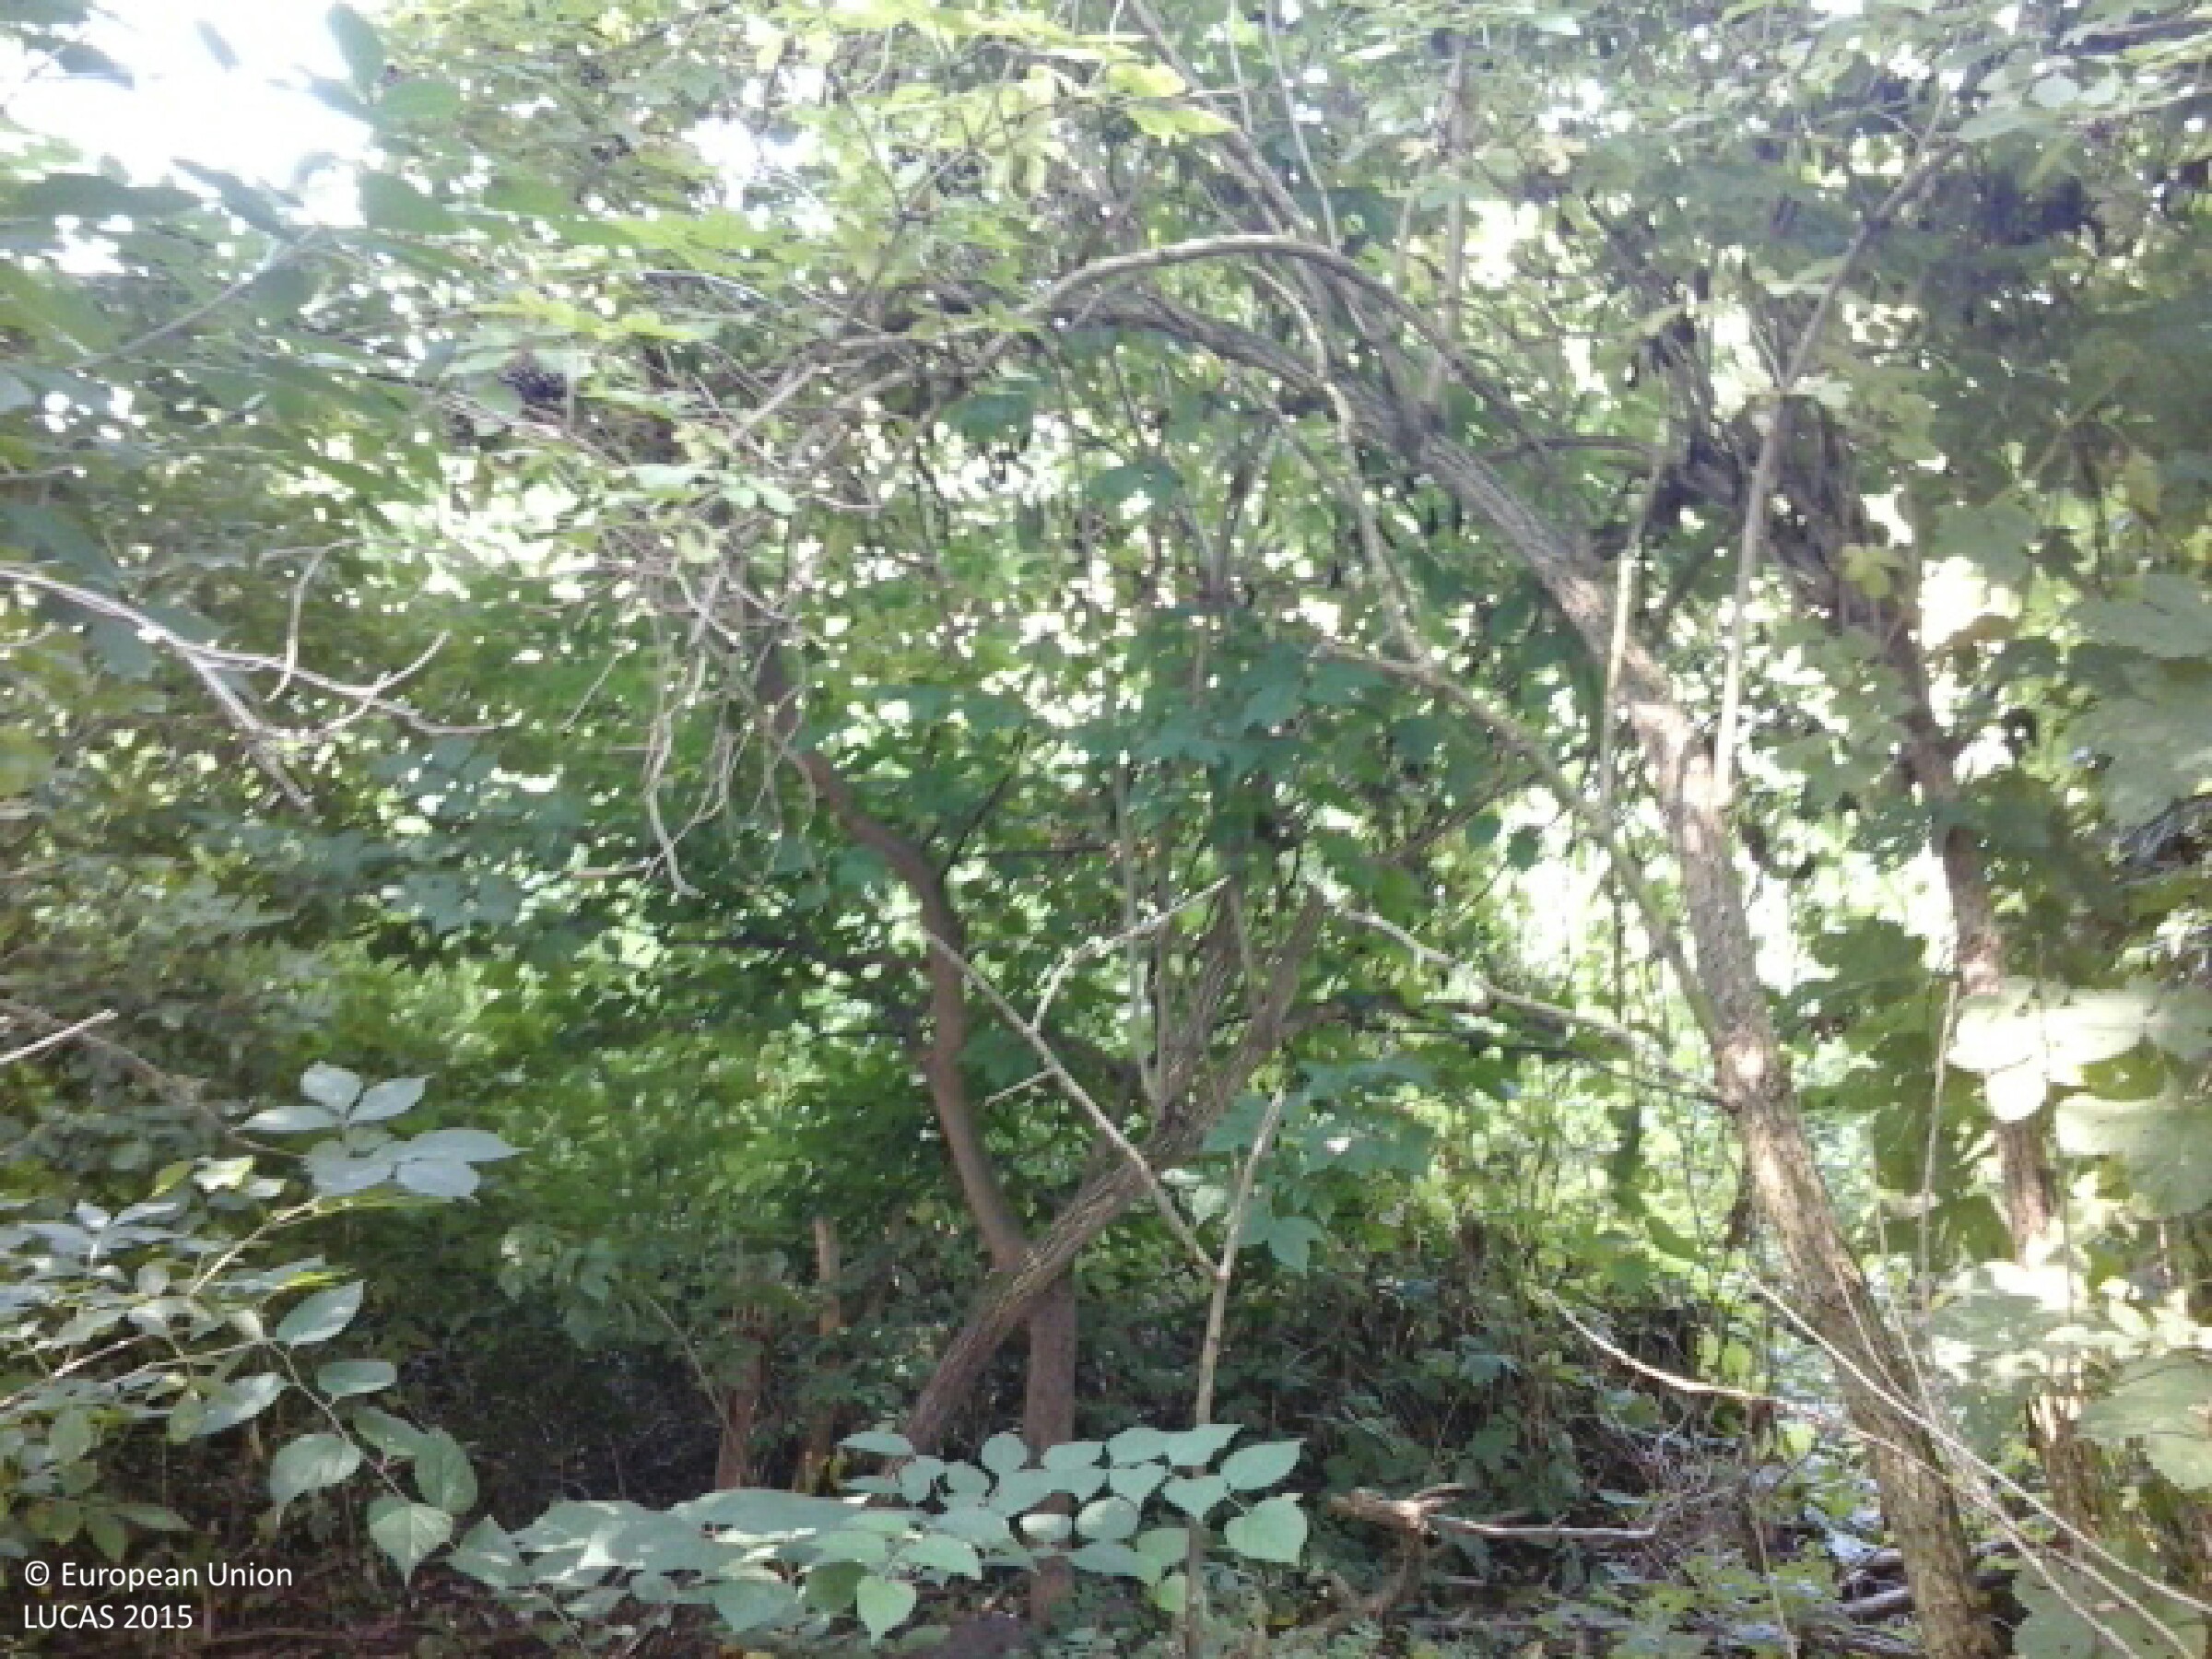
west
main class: Woodland
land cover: Broadleaved woodland
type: mesophytic deciduous forest
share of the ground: > 75 %
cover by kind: broadleaved forest trees 100 %
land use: Semi-natural and natural areas not in use
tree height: > 5 m
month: August
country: HU
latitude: 47.7060
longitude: 18.1285
